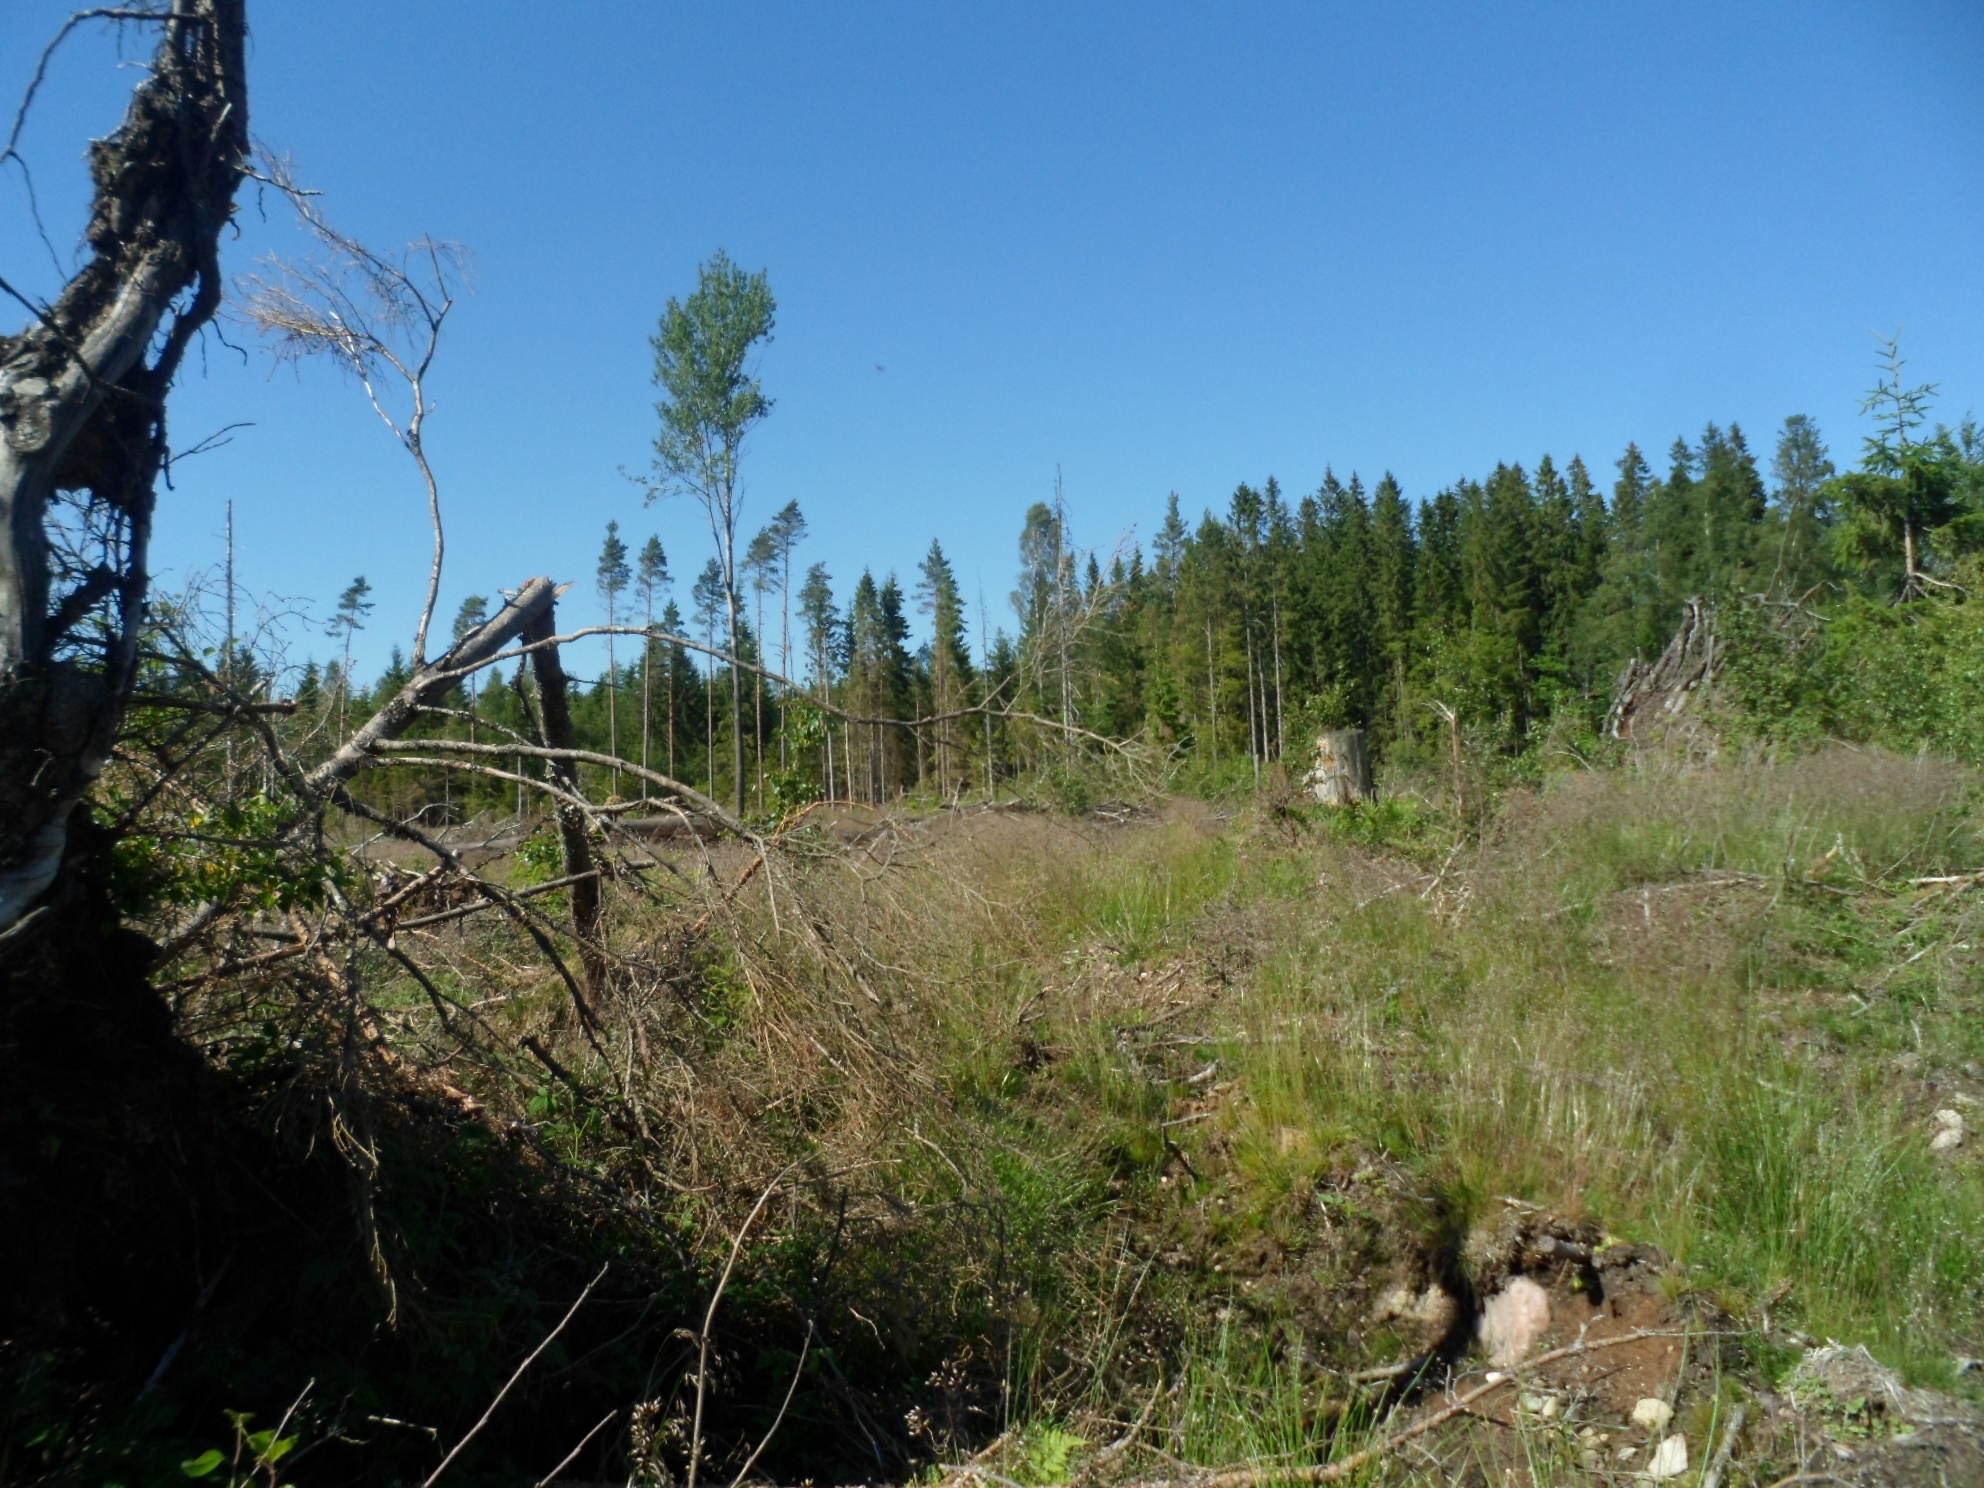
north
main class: Woodland
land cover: Spruce dominated mixed woodland
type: boreal forest
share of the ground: 10 - 25 %
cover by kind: herbaceous plants 40 %, shrubs 20 %, broadleaved forest trees 15 %, coniferous forest trees 10 %, lichens and mosses 10 %, unconsolidated bare surface 5 %
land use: Forestry
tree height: < 5 m
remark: Clear cut
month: July
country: SE
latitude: 57.1352
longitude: 14.5071
